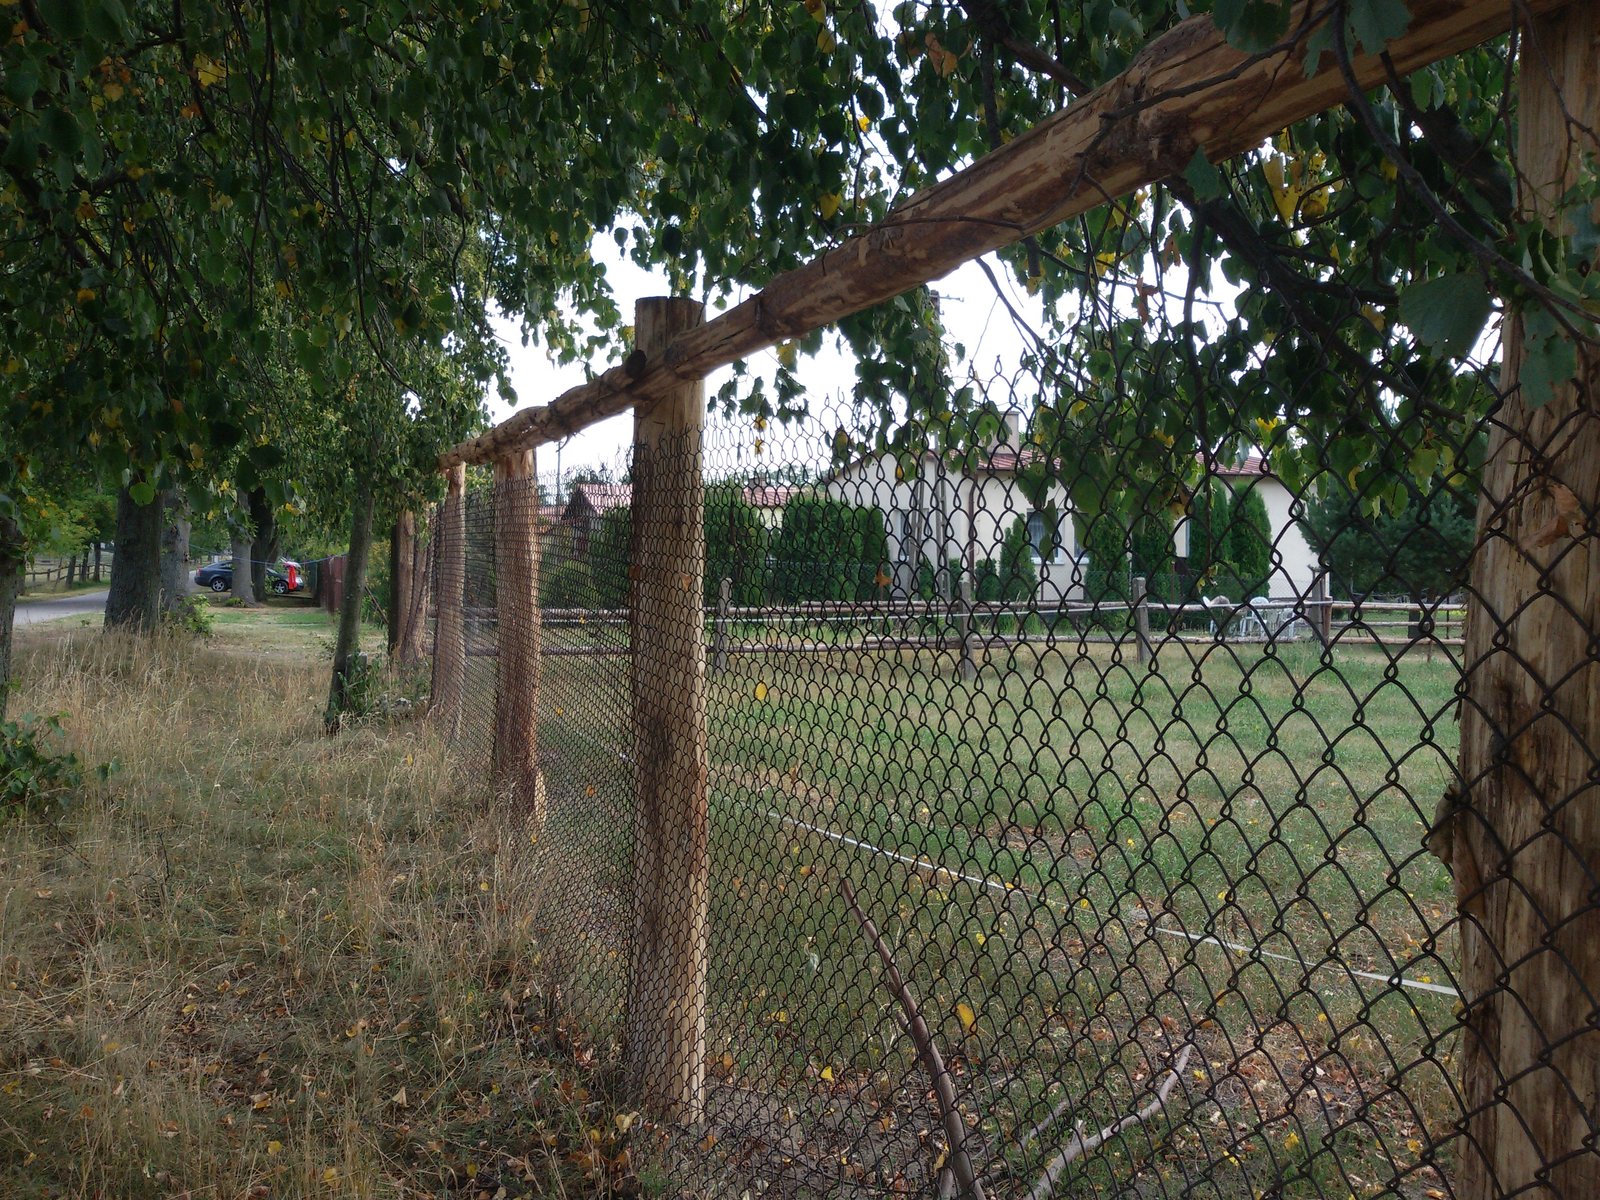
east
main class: Grassland
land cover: Grassland without tree/shrub cover
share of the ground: > 75 %
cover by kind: herbaceous plants 100 %
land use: Agriculture (excluding fallow land and kitchen gardens)
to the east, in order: Grassland without tree/shrub cover; Artificial constructions in urban areas; Grassland without tree/shrub cover
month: August
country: PL
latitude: 53.7488
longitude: 21.6219
